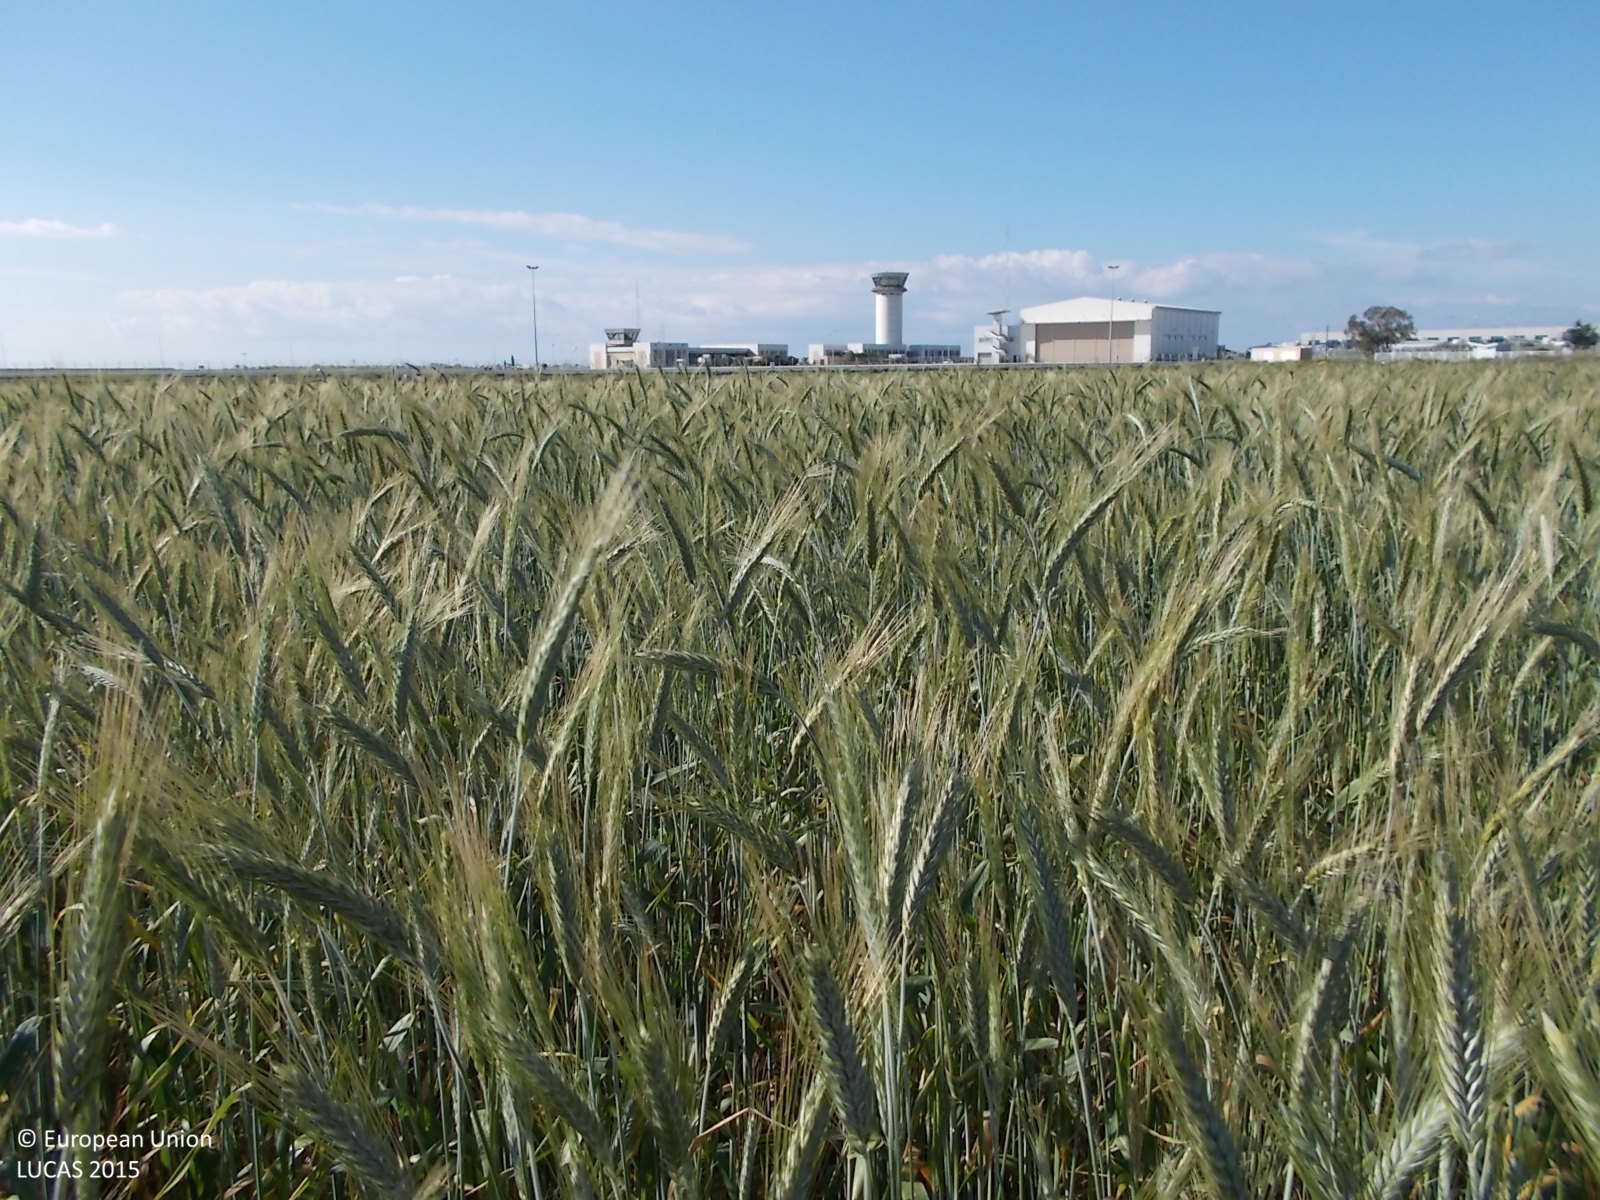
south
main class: Cropland
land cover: Common wheat
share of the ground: > 75 %
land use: Agriculture (excluding fallow land and kitchen gardens)
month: April
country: CY
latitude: 34.8777
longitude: 33.6182
